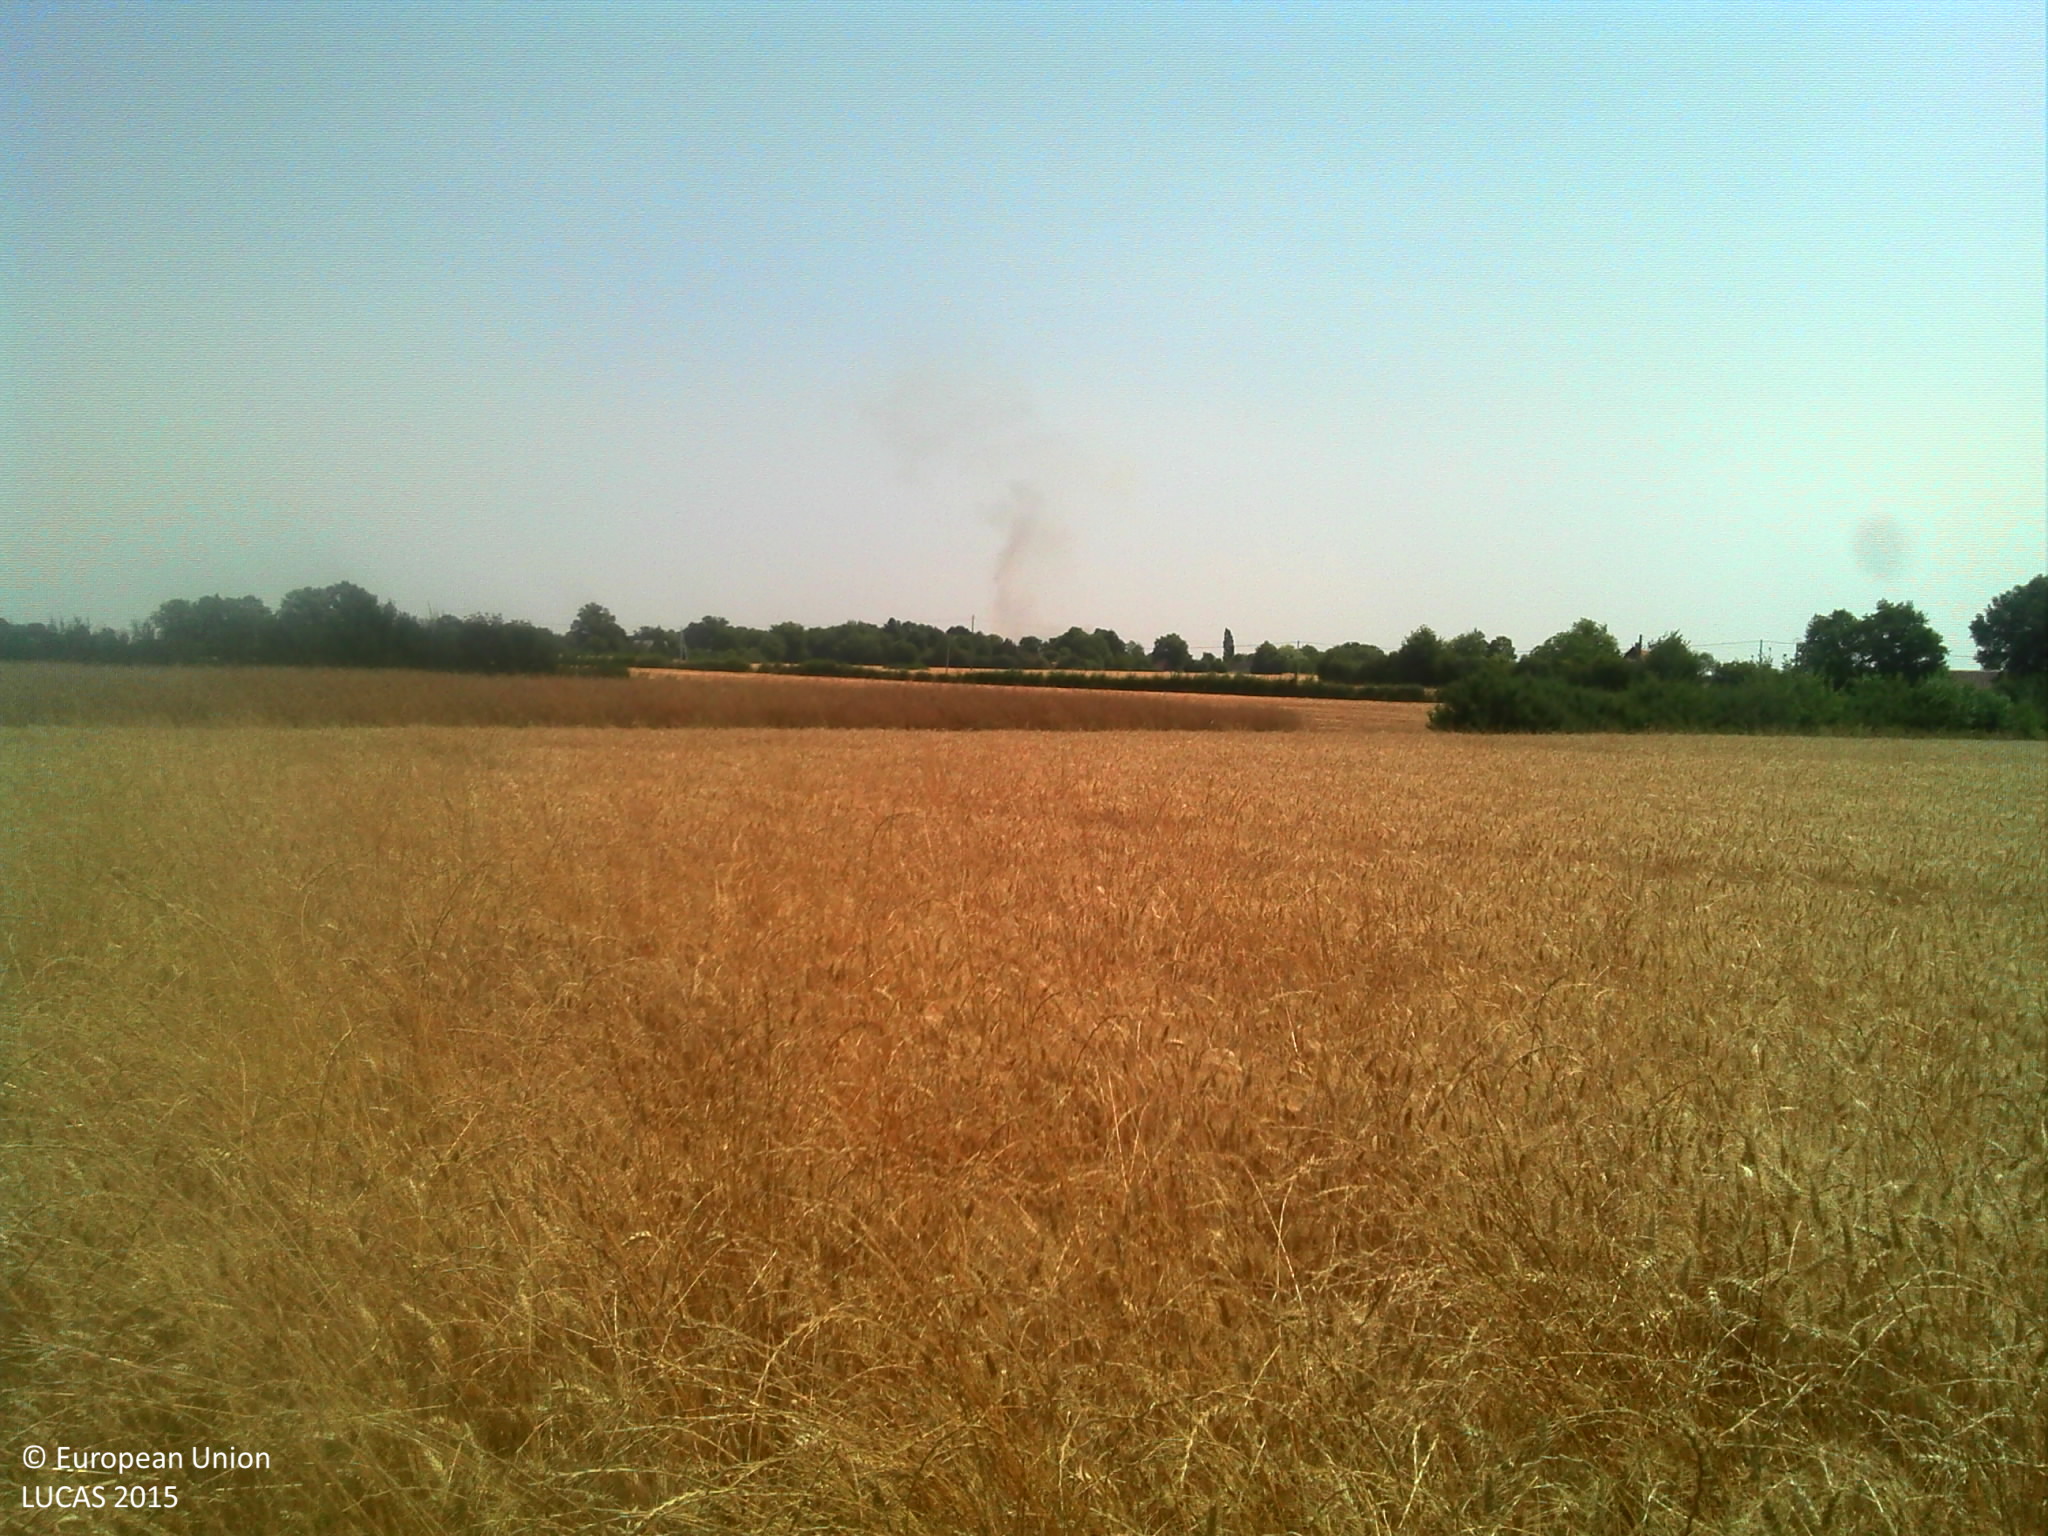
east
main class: Cropland
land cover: Rape and turnip rape
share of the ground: > 75 %
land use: Agriculture (excluding fallow land and kitchen gardens)
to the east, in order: Rape and turnip rape; Electric lines; Rape and turnip rape; Managed hedges; Dry pulses
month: July
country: FR
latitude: 48.1501
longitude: 1.0692
